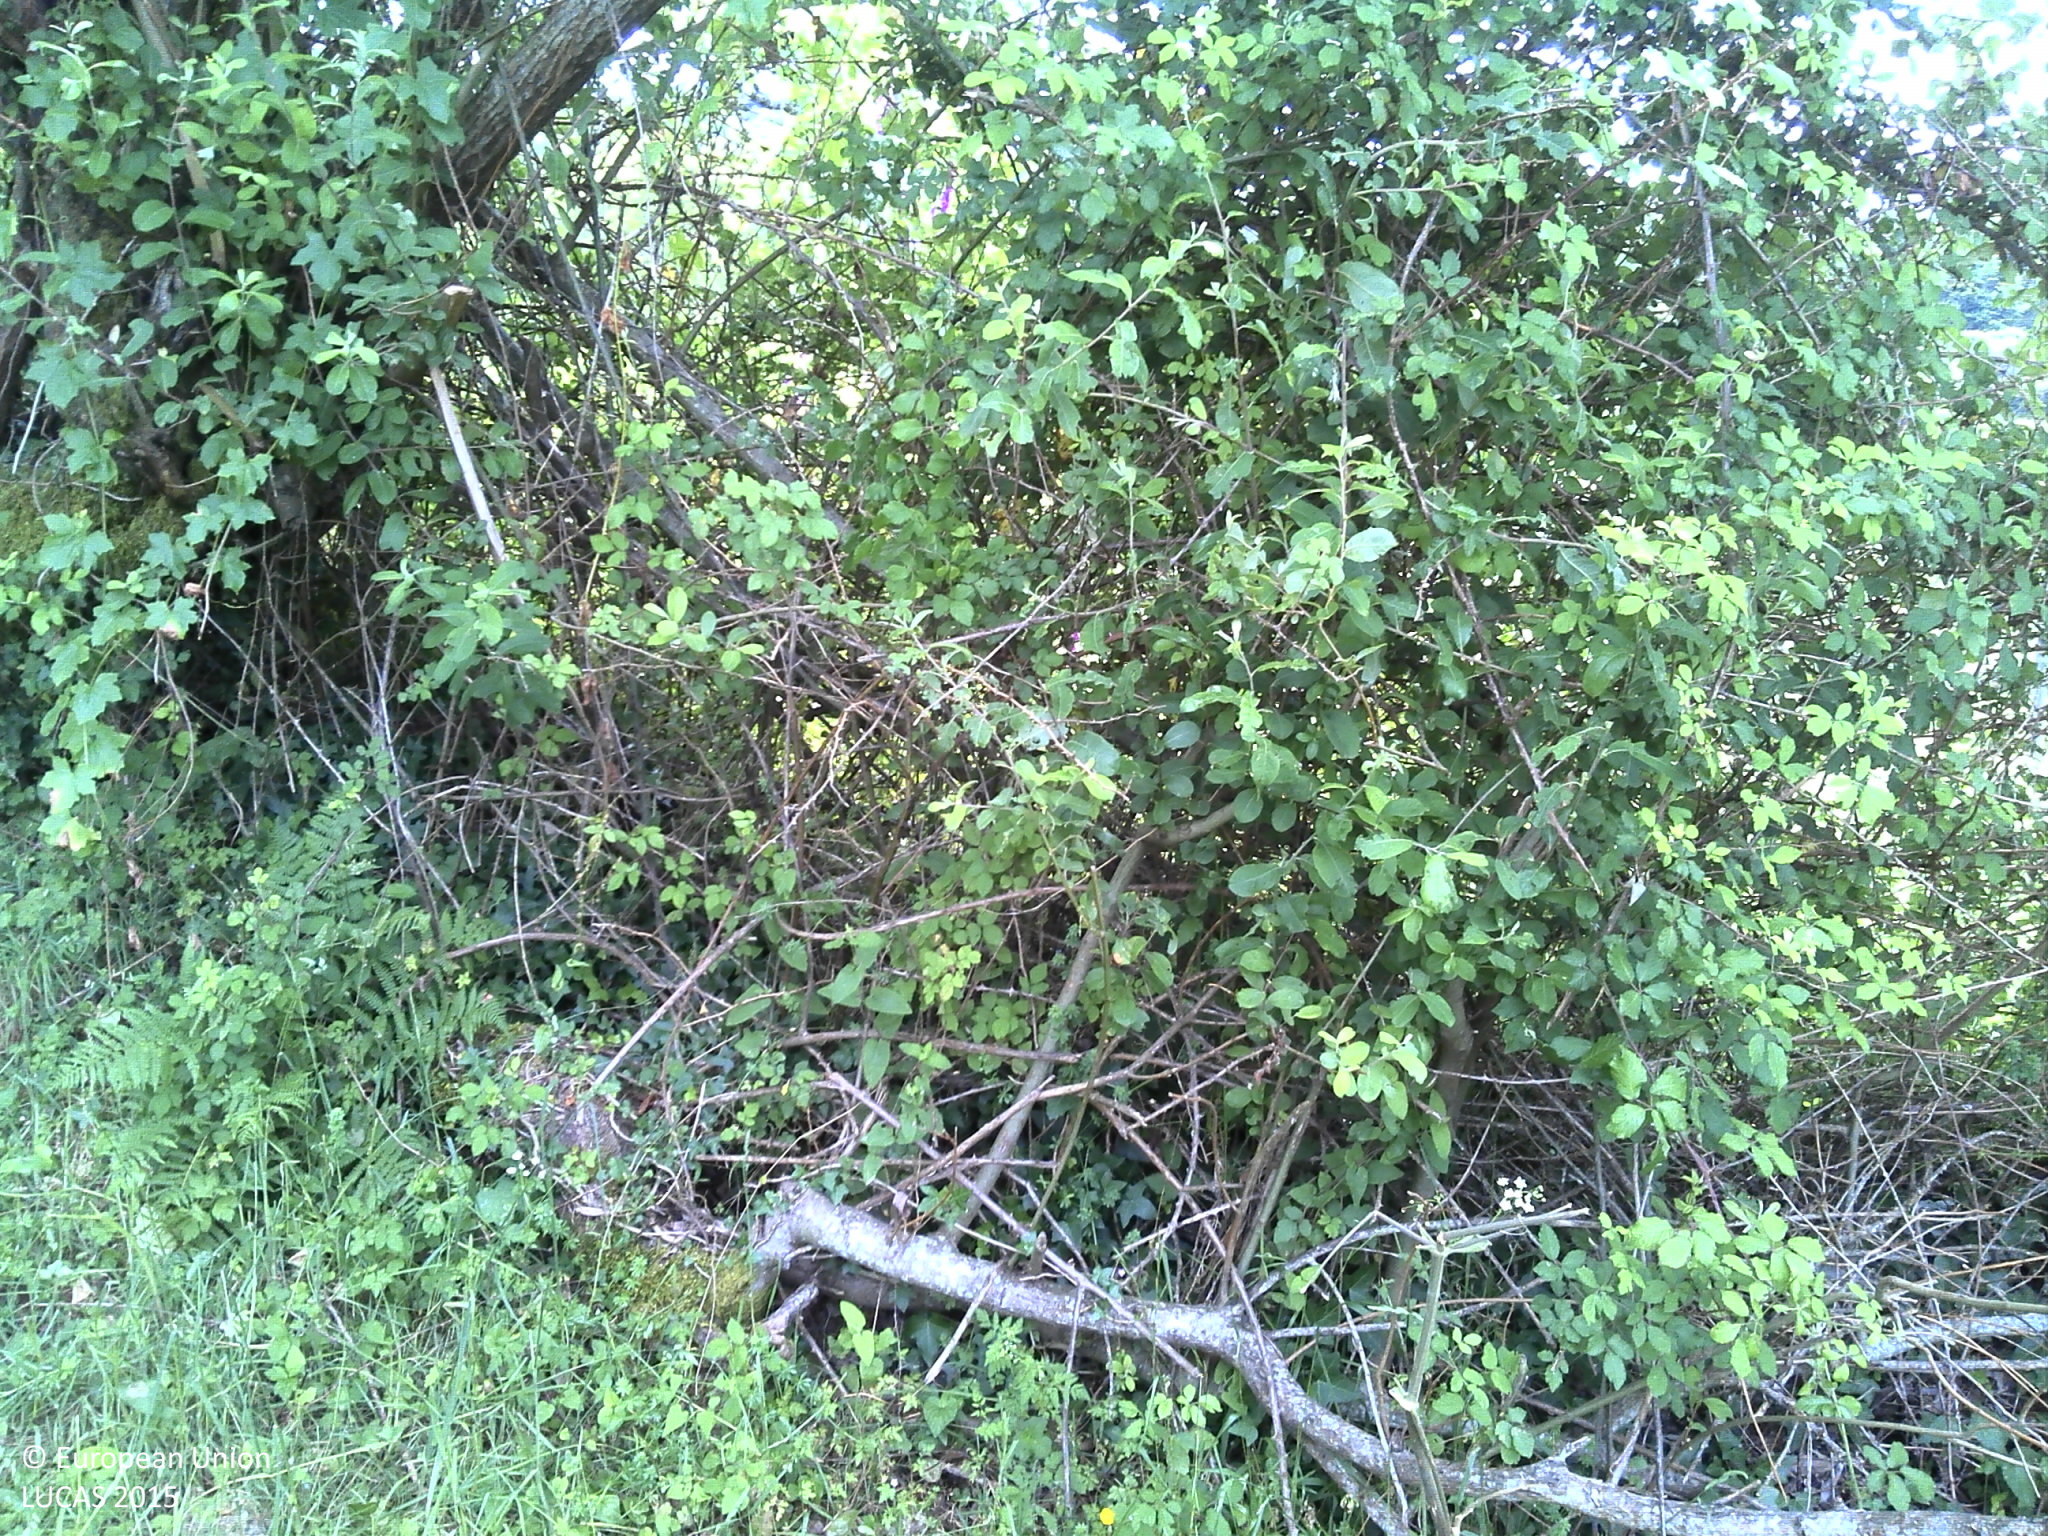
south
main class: Grassland
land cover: Grassland without tree/shrub cover
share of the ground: > 75 %
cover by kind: herbaceous plants 90 %, shrubs 5 %, consolidated bare surface 5 %
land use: Agriculture (excluding fallow land and kitchen gardens)
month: June
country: PT
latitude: 41.7633
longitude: -8.4037
